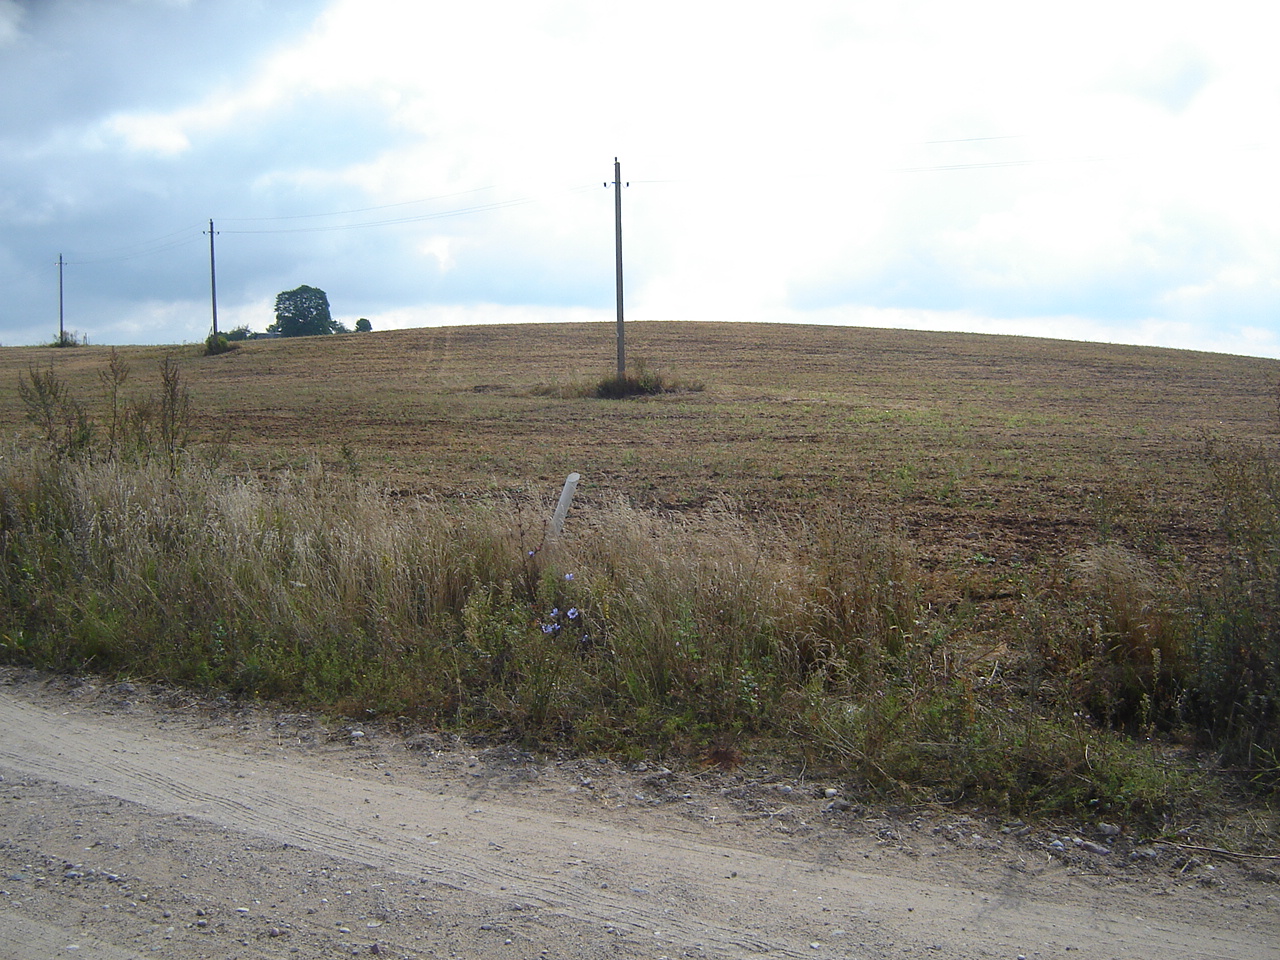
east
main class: Grassland
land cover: Grassland with sparse tree/shrub cover
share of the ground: > 75 %
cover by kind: herbaceous plants 90 %, coniferous forest trees 5 %, shrubs 5 %
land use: Fallow land
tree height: > 5 m
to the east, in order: Grassland with sparse tree/shrub cover; Paved roads, cycling and walking lanes; Shruby margins; Other bare soil; Electric lines; Other bare soil; Spontaneously vegetated surfaces
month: August
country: LT
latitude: 54.7280
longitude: 24.7194
